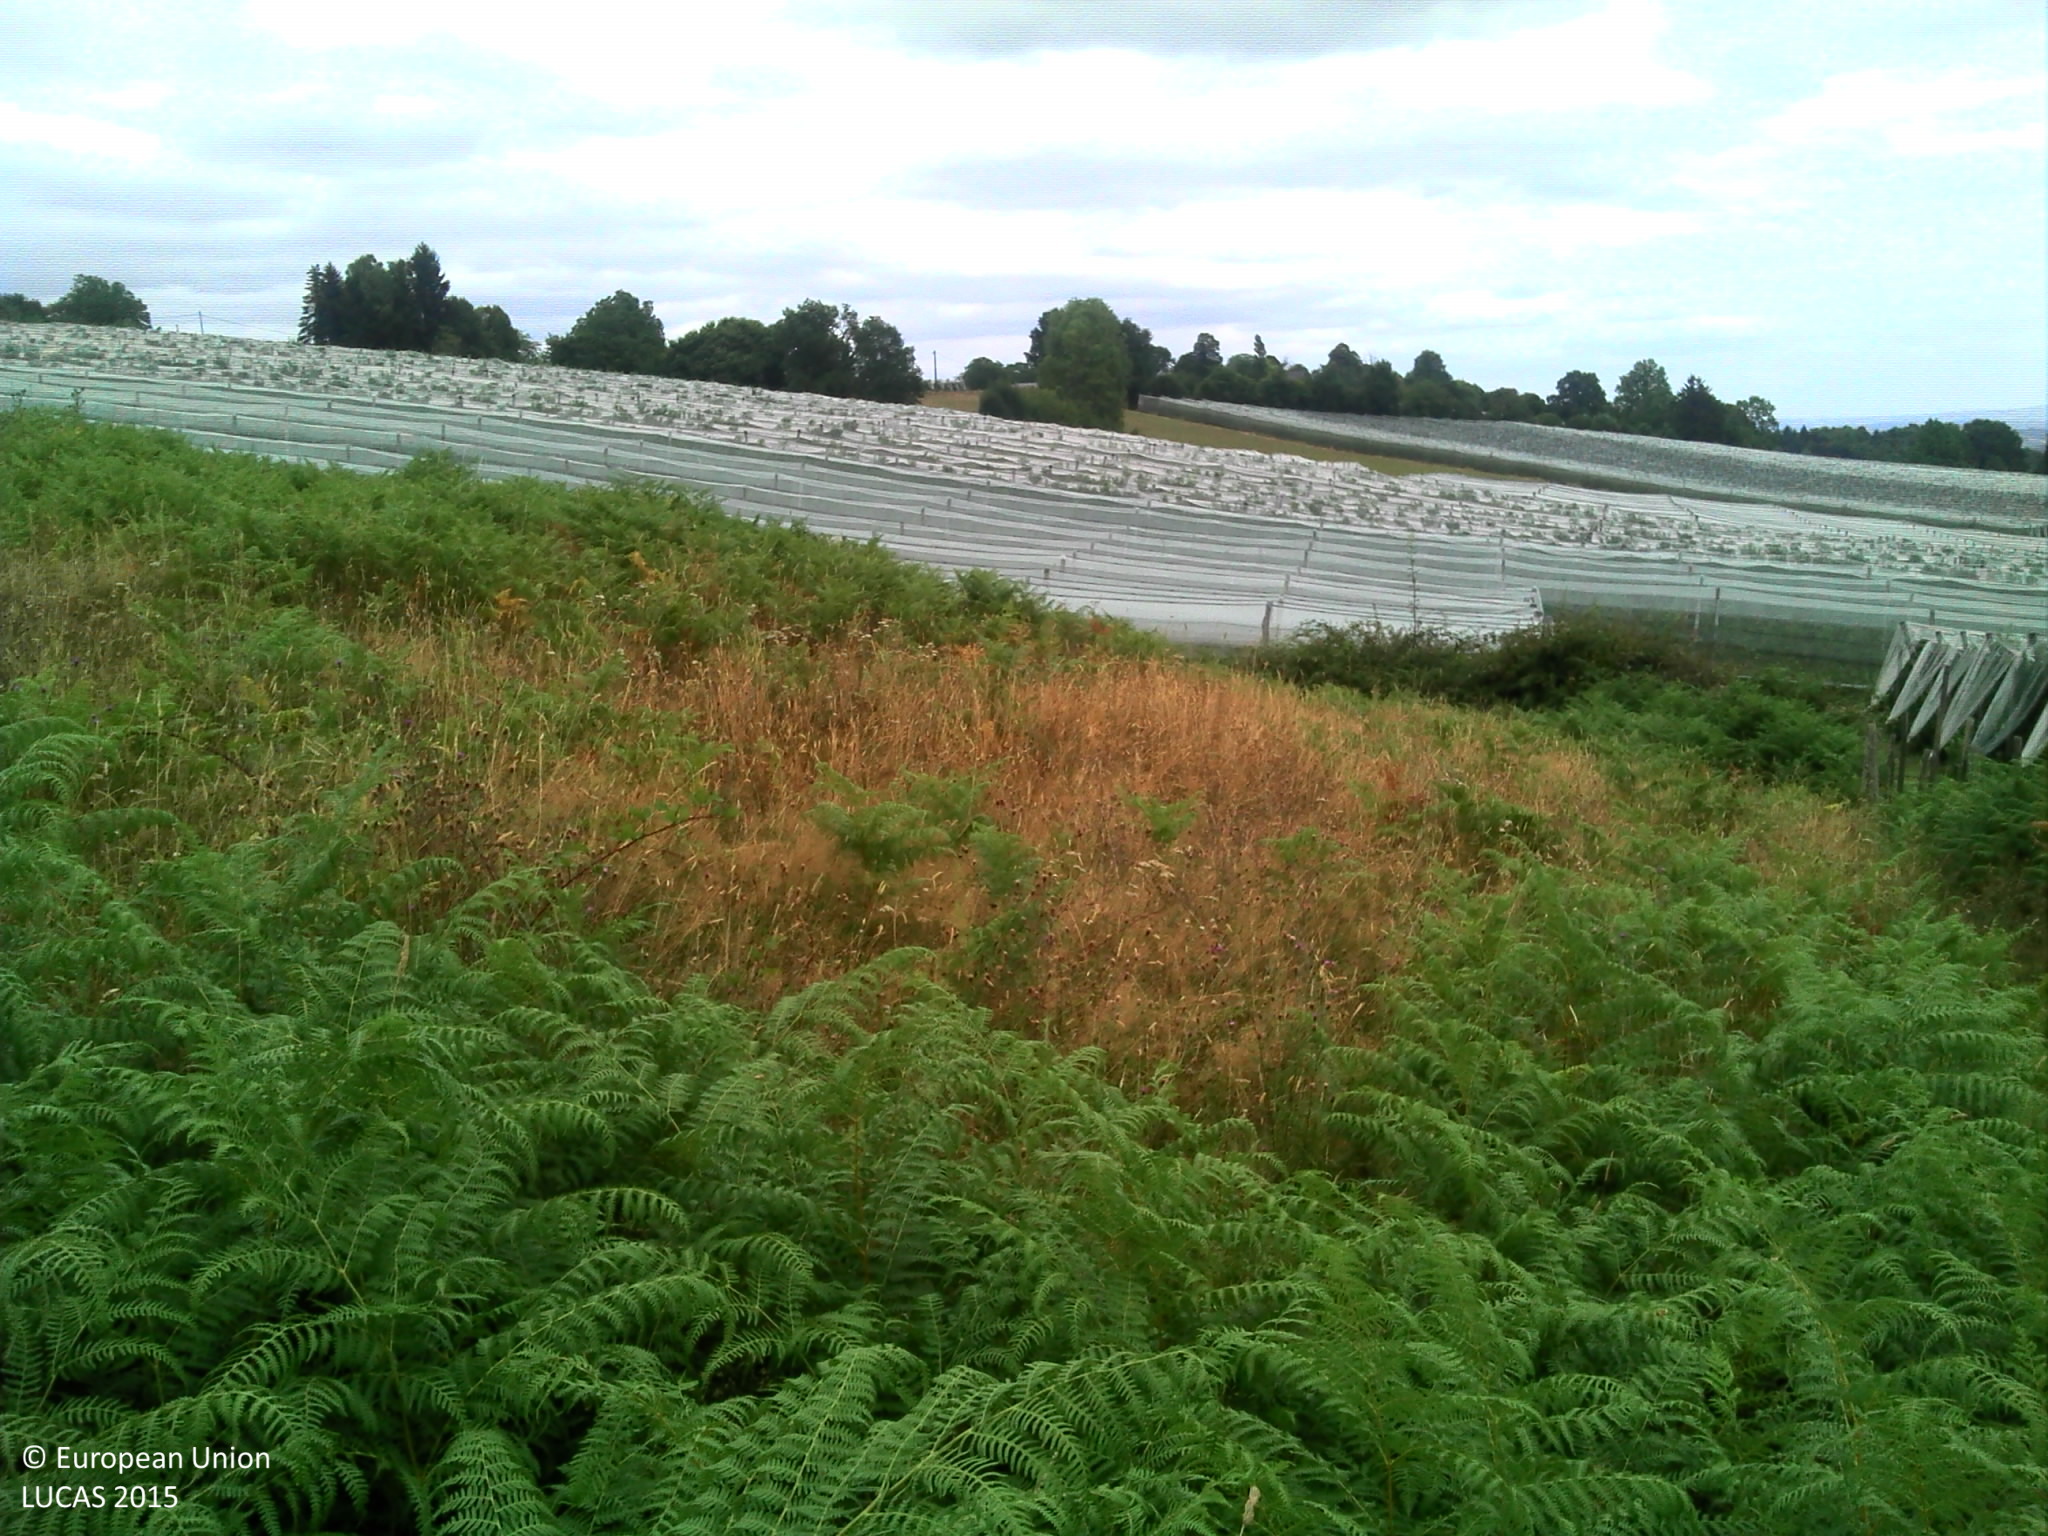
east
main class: Grassland
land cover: Spontaneously vegetated surfaces
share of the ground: > 75 %
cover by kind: herbaceous plants 95 %, shrubs 5 %
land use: Semi-natural and natural areas not in use
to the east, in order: Spontaneously vegetated surfaces; Fences; Grass margins; Tracks; Apple fruit; Tracks; Grassland without tree/shrub cover
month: July
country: FR
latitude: 45.3463
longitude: 1.3272
